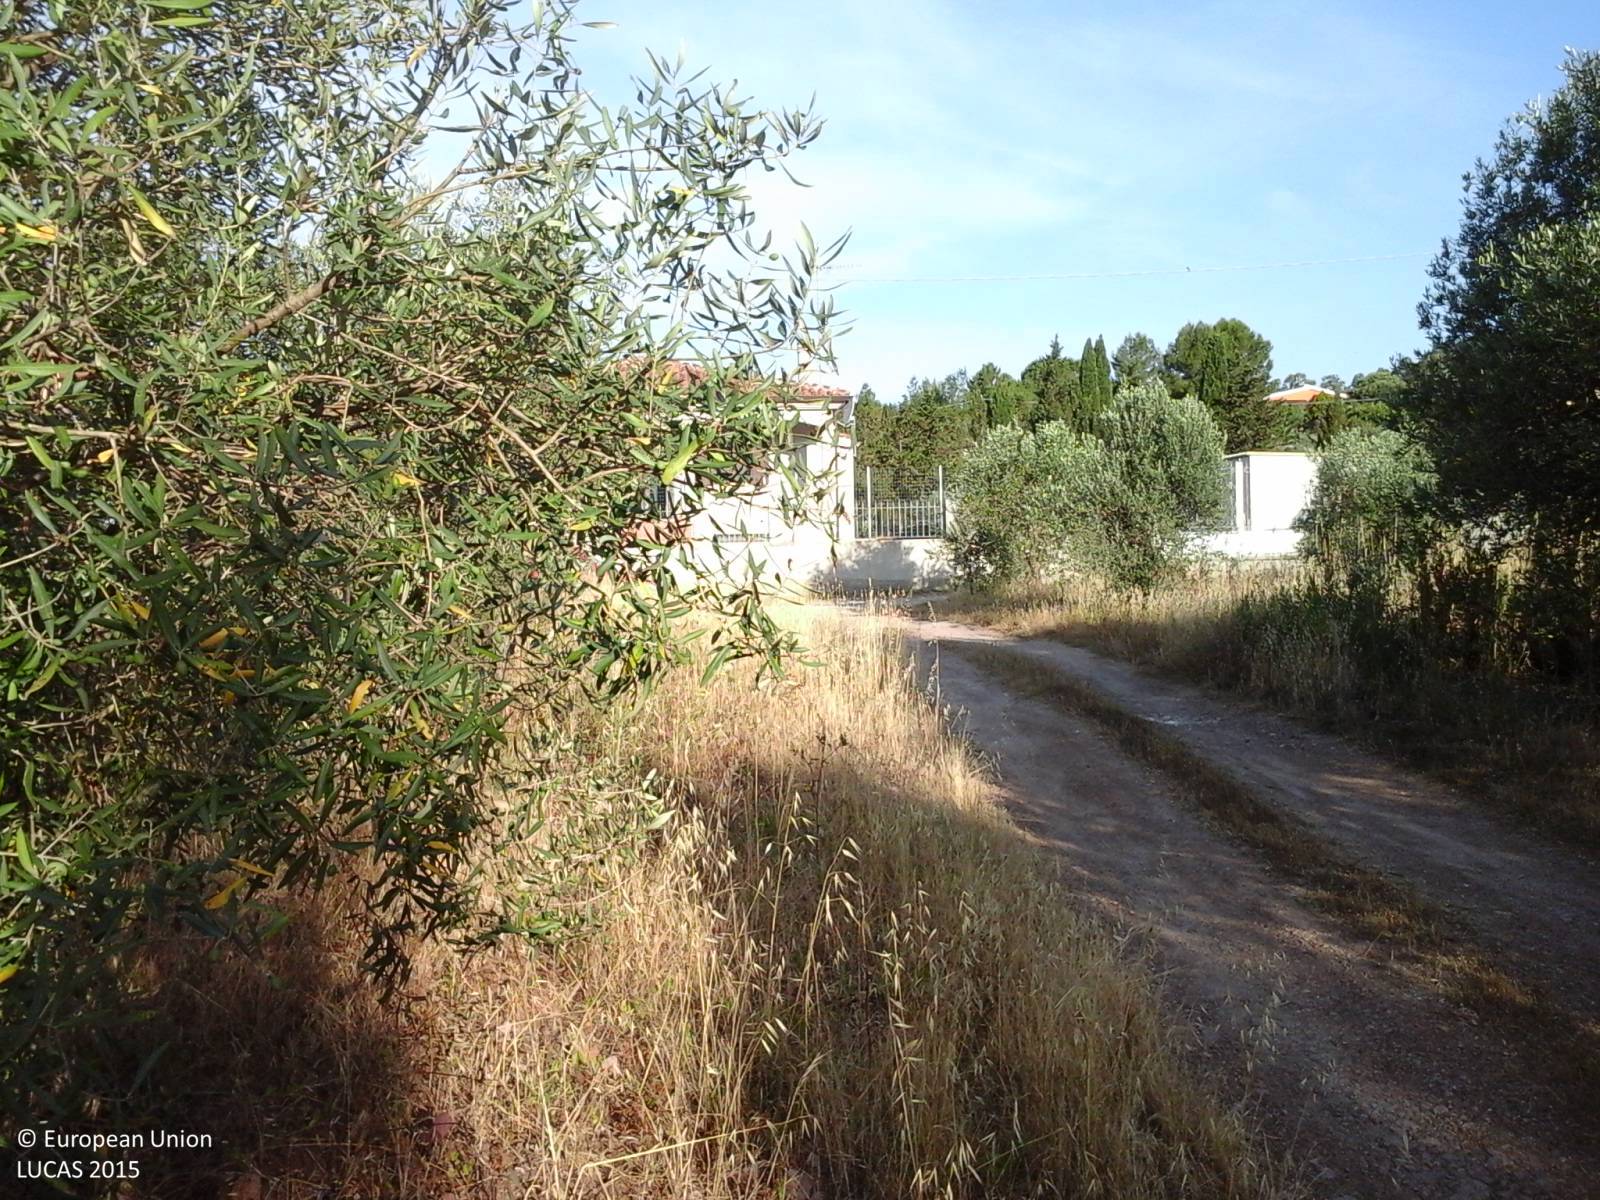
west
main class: Cropland
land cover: Olive groves
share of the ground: < 10 %
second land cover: Grassland without tree/shrub cover
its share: 50 - 75 %
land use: Agriculture (excluding fallow land and kitchen gardens)
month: June
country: IT
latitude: 40.5800
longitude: 8.3894
